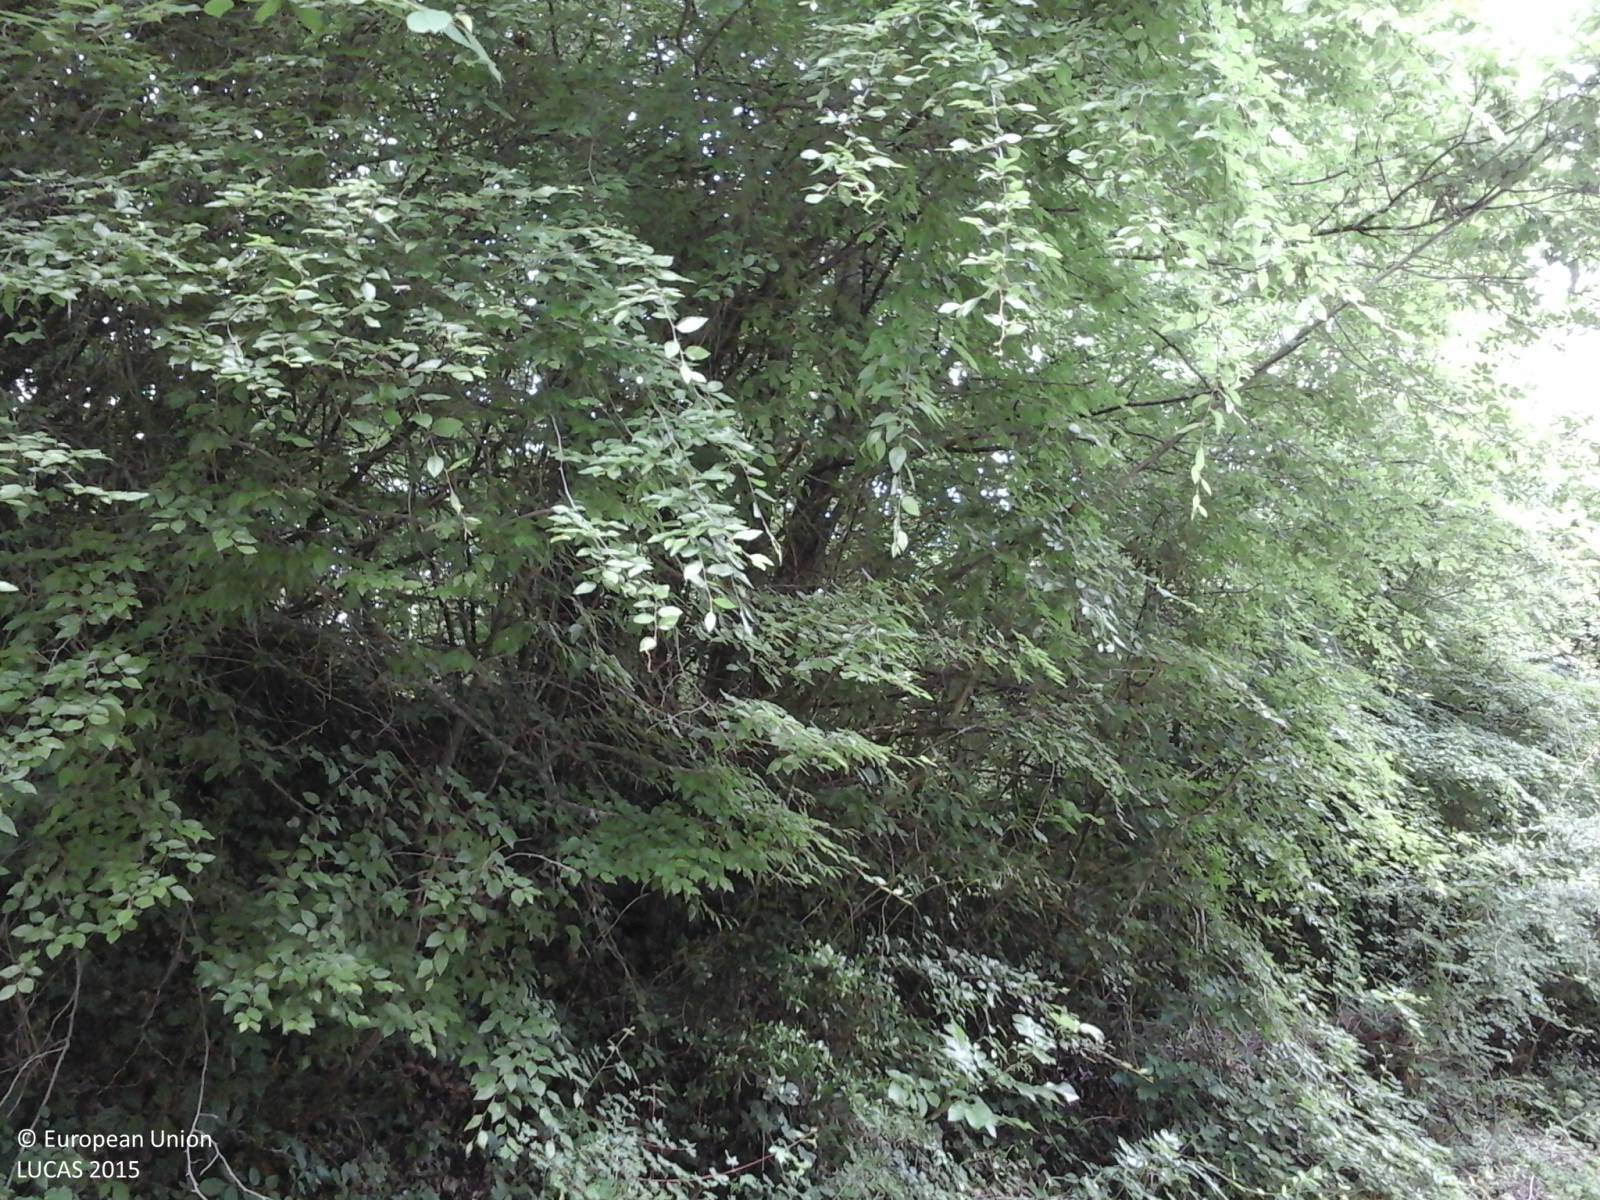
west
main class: Woodland
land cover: Broadleaved woodland
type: thermophilous deciduous forest
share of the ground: > 75 %
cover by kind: broadleaved forest trees 100 %
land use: Forestry
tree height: < 5 m
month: May
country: IT
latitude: 41.2432
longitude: 14.2673
